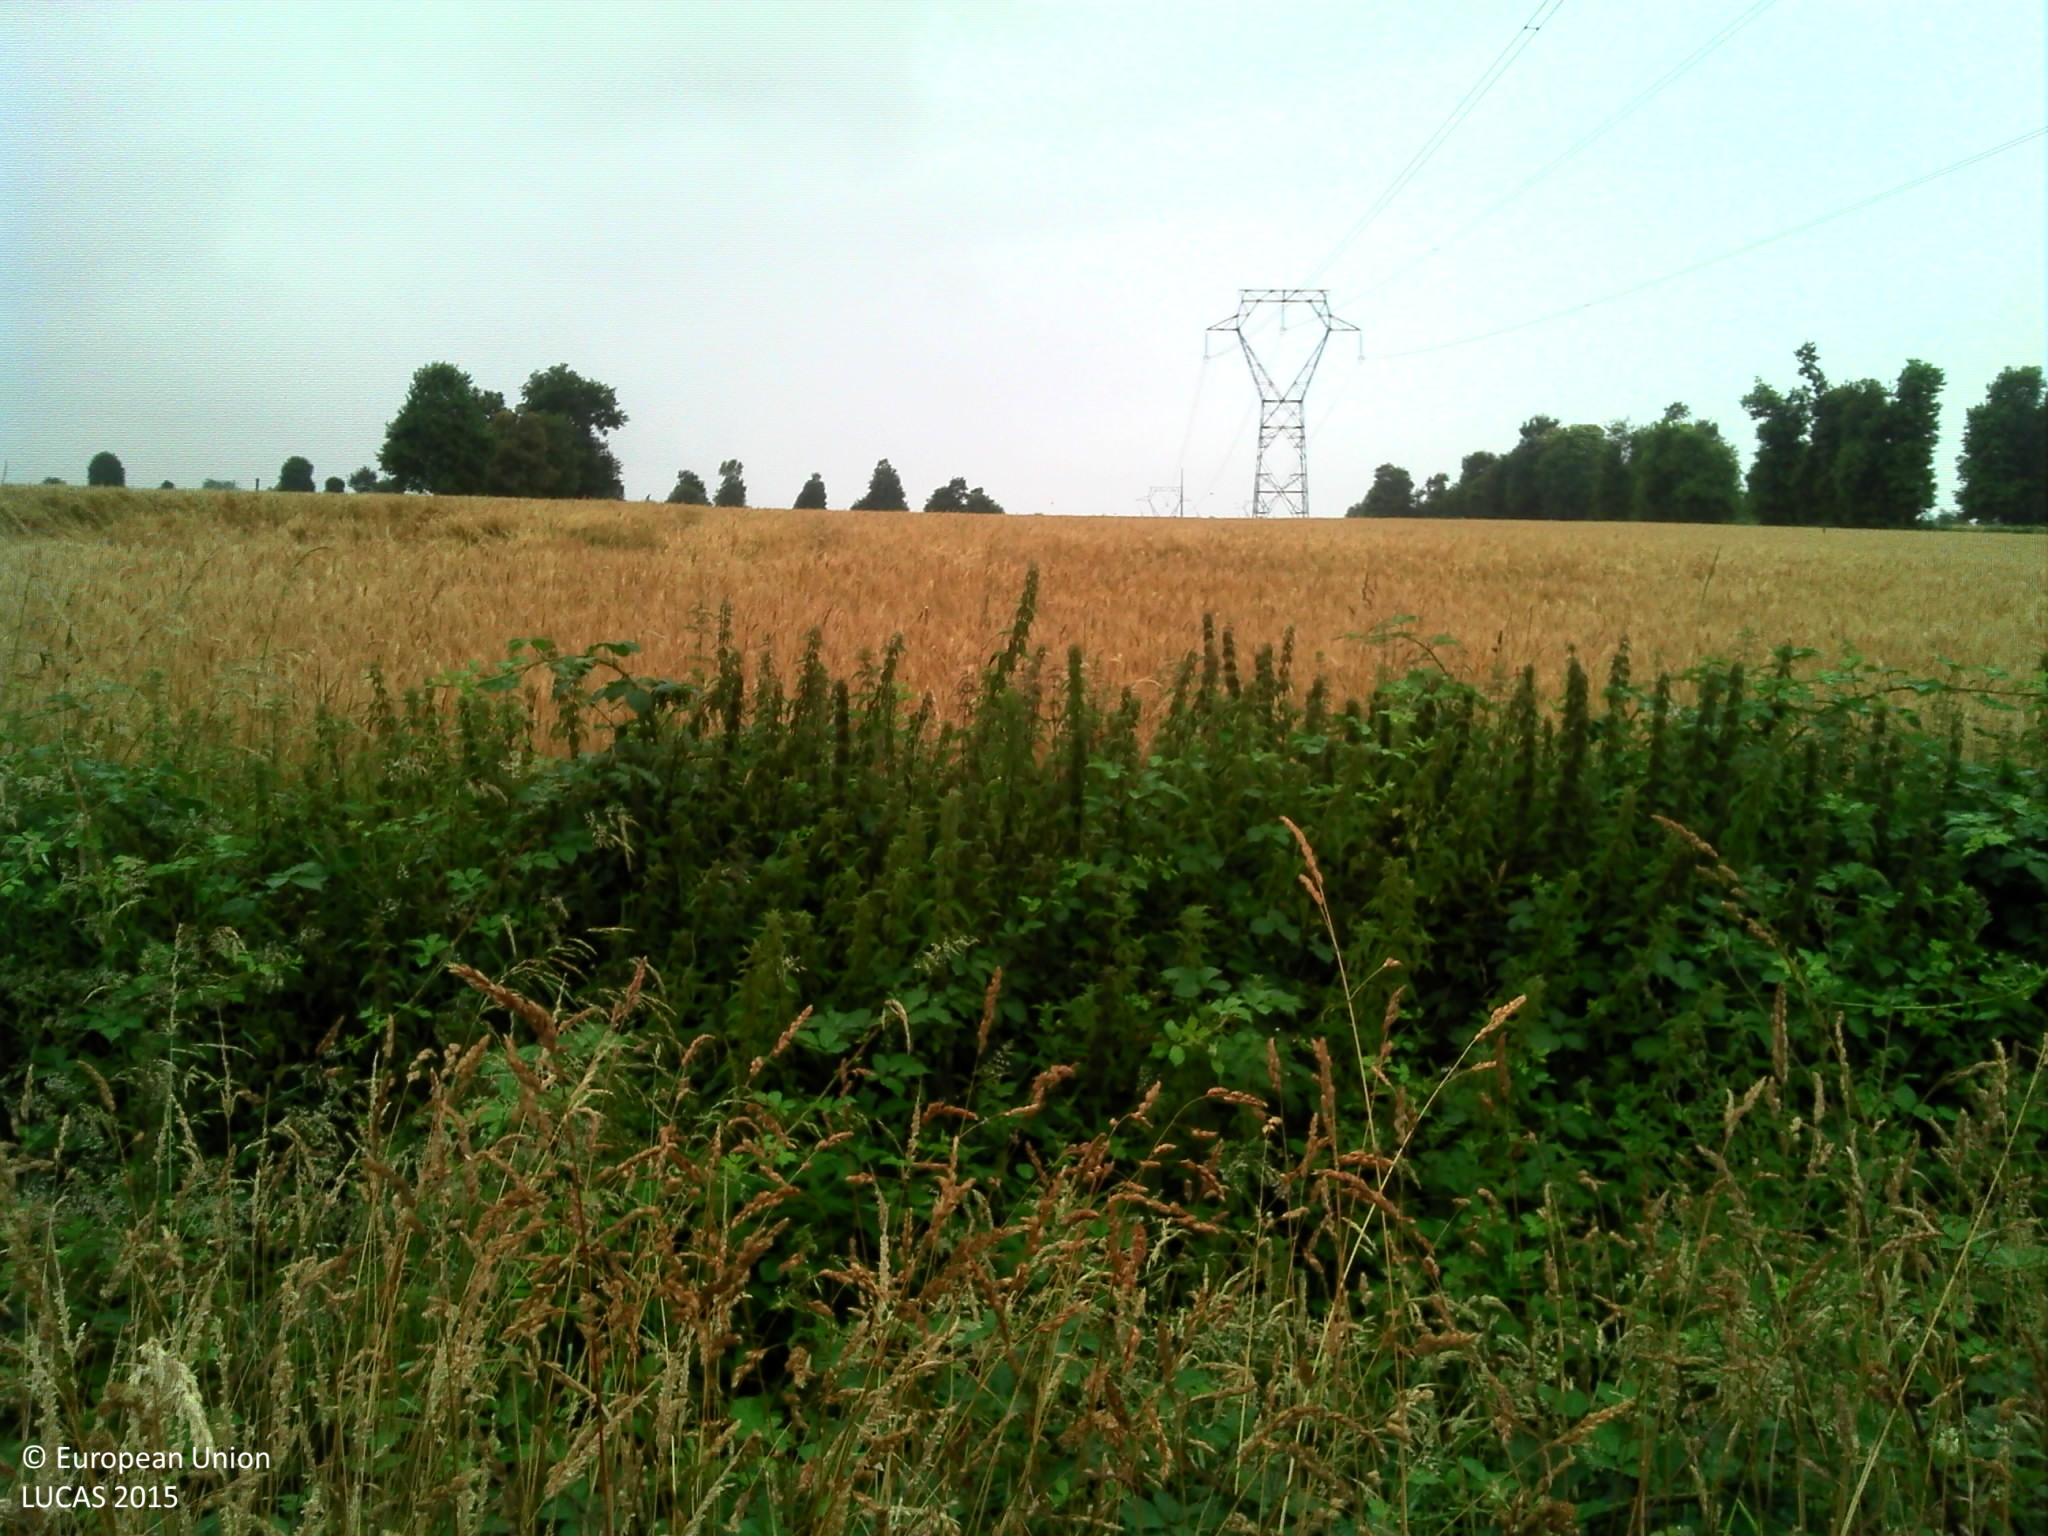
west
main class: Cropland
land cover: Maize
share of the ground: > 75 %
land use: Agriculture (excluding fallow land and kitchen gardens)
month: July
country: FR
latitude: 48.2388
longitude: -1.9962
